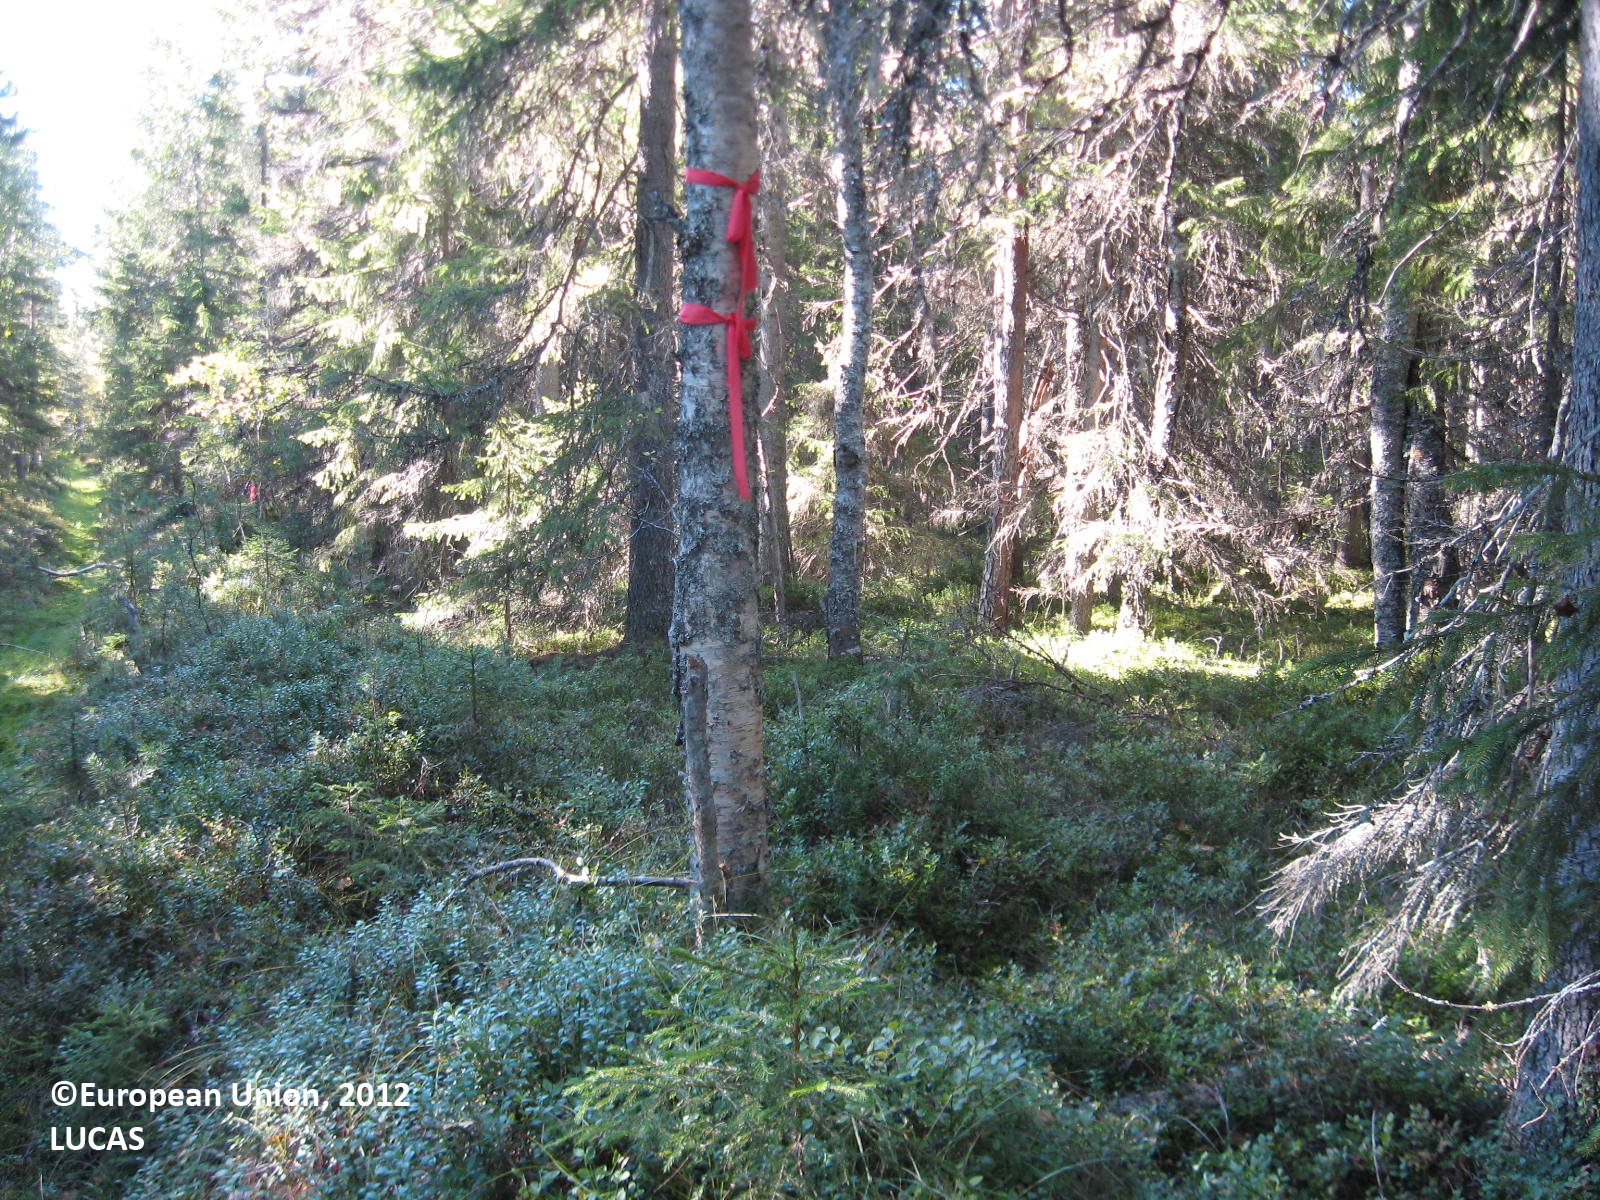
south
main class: Woodland
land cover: Spruce dominated coniferous woodland
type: boreal forest
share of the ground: > 75 %
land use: Forestry
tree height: > 5 m
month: August
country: FI
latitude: 63.7263
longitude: 29.8170
